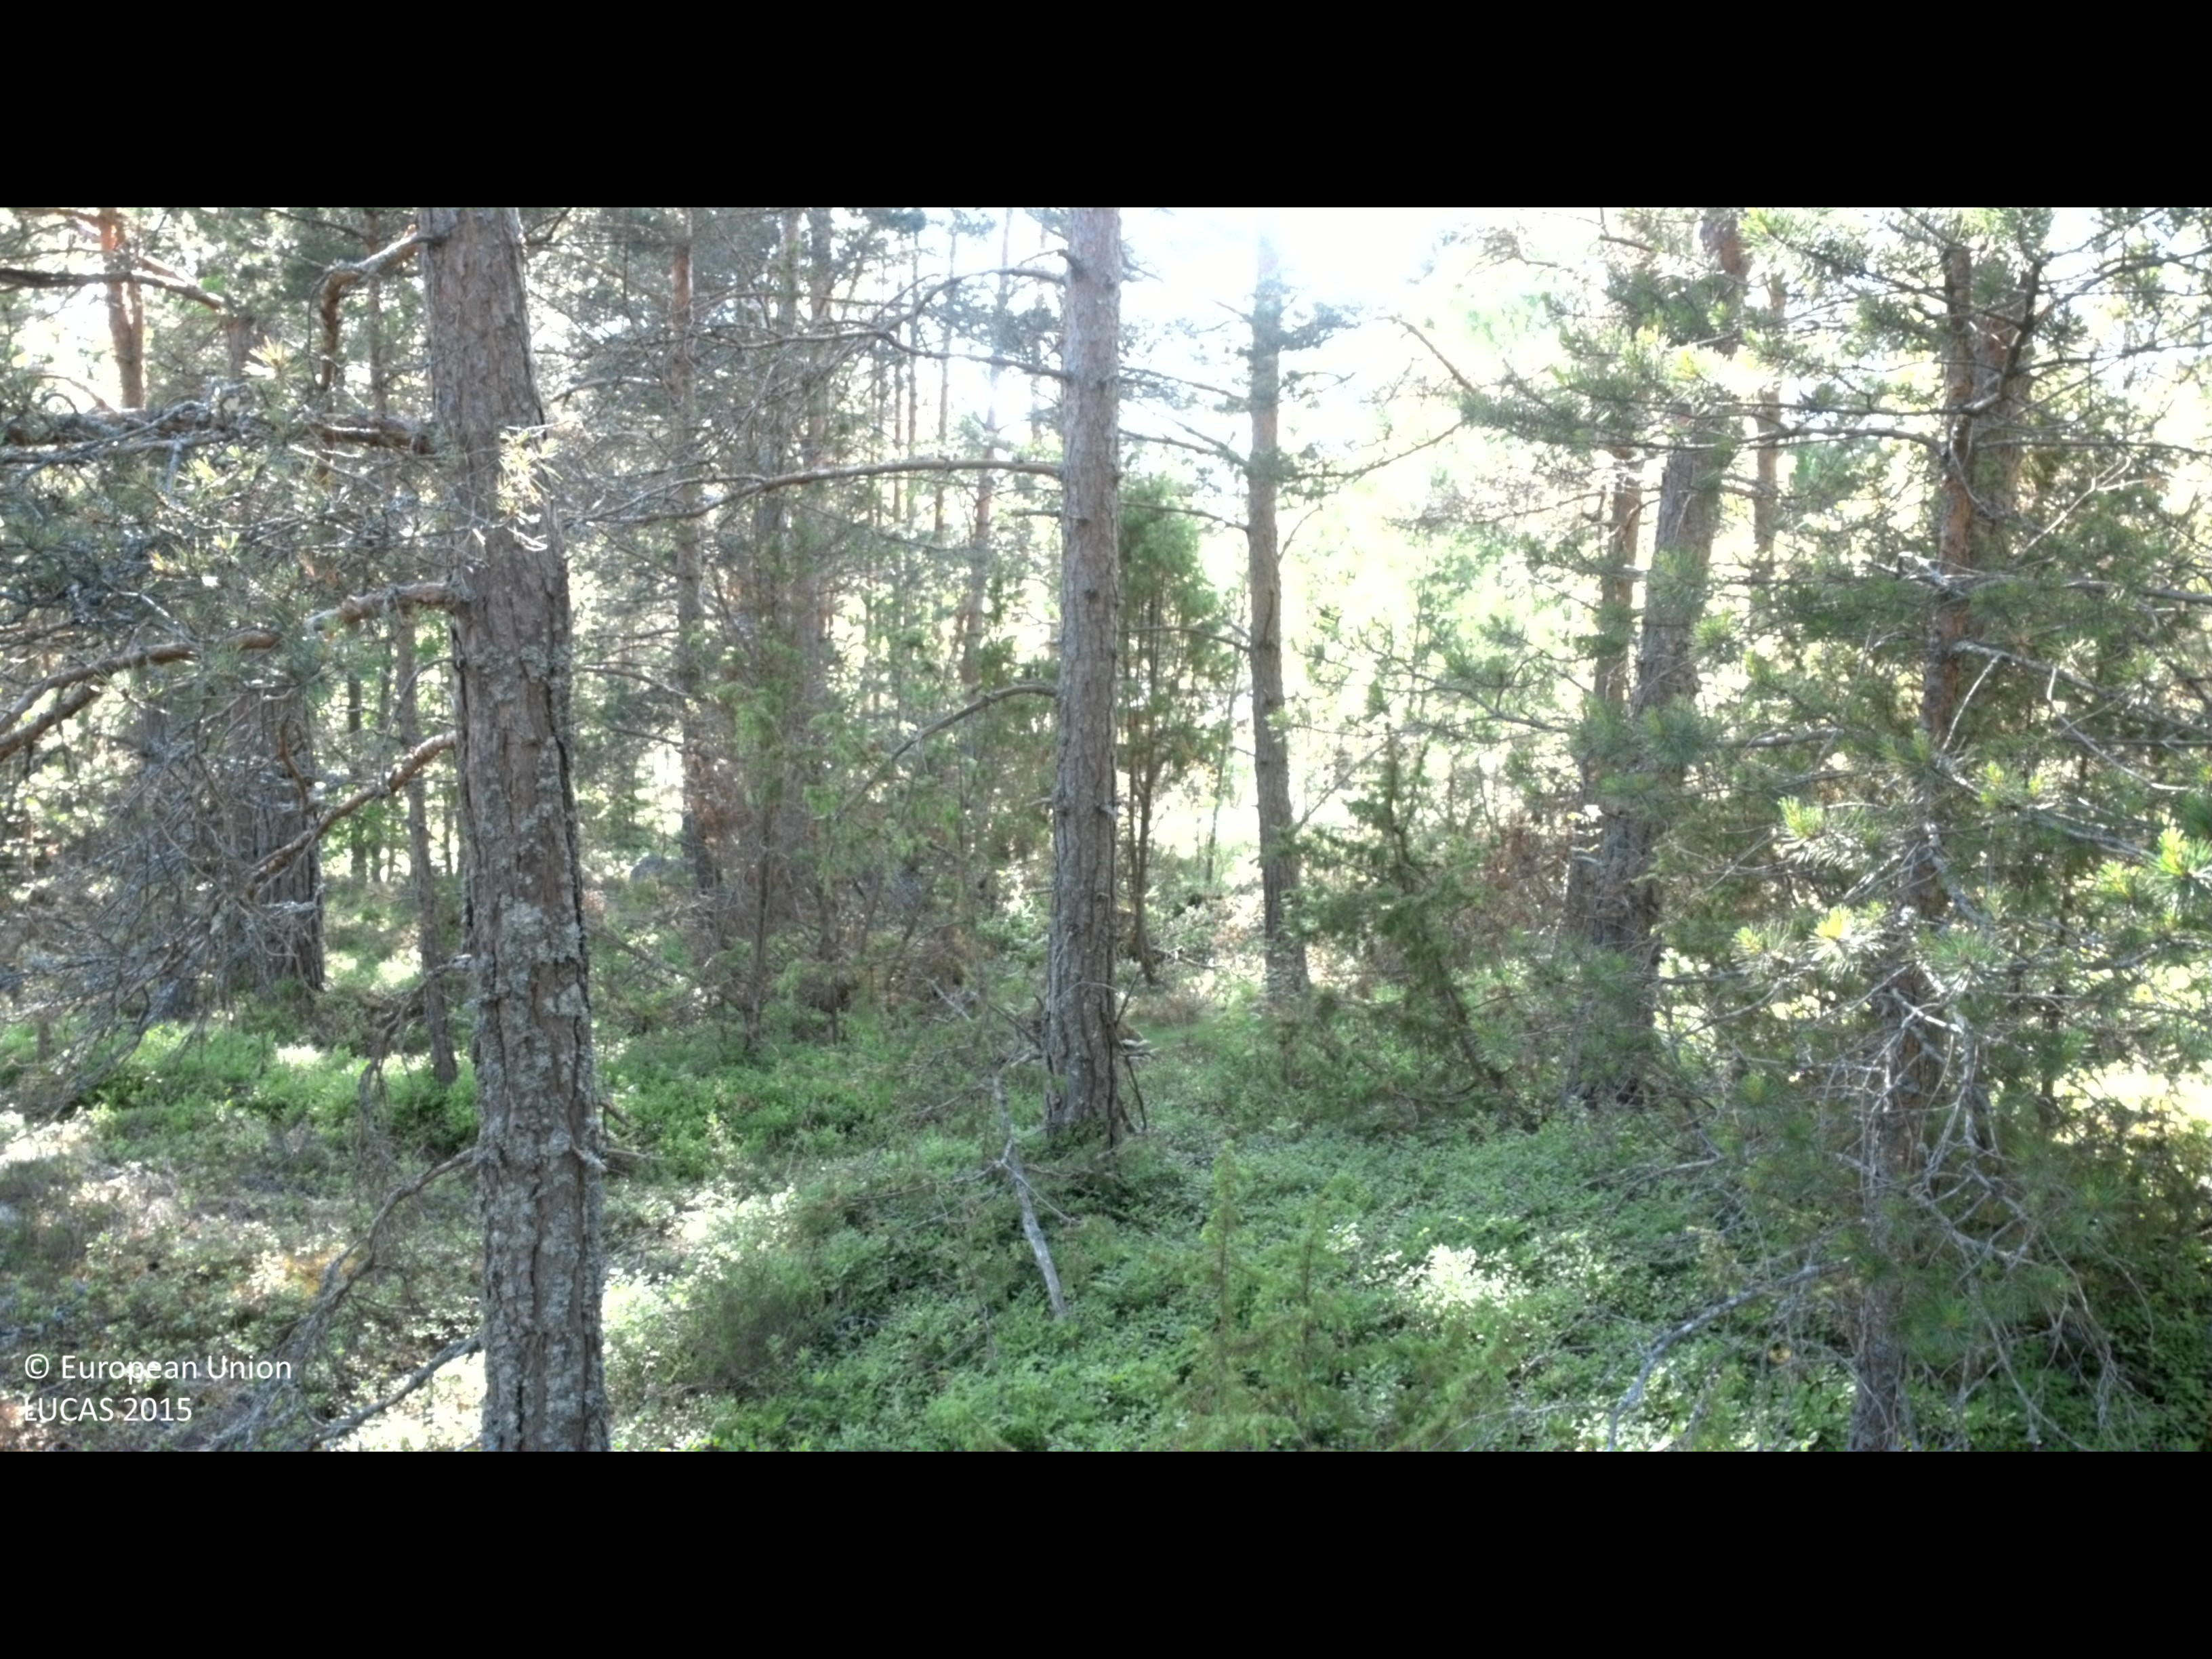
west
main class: Woodland
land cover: Pine dominated coniferous woodland
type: boreal forest
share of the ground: 50 - 75 %
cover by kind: coniferous forest trees 75 %, shrubs 15 %, lichens and mosses 10 %
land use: Forestry
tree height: > 5 m
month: June
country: SE
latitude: 57.8885
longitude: 16.7286
